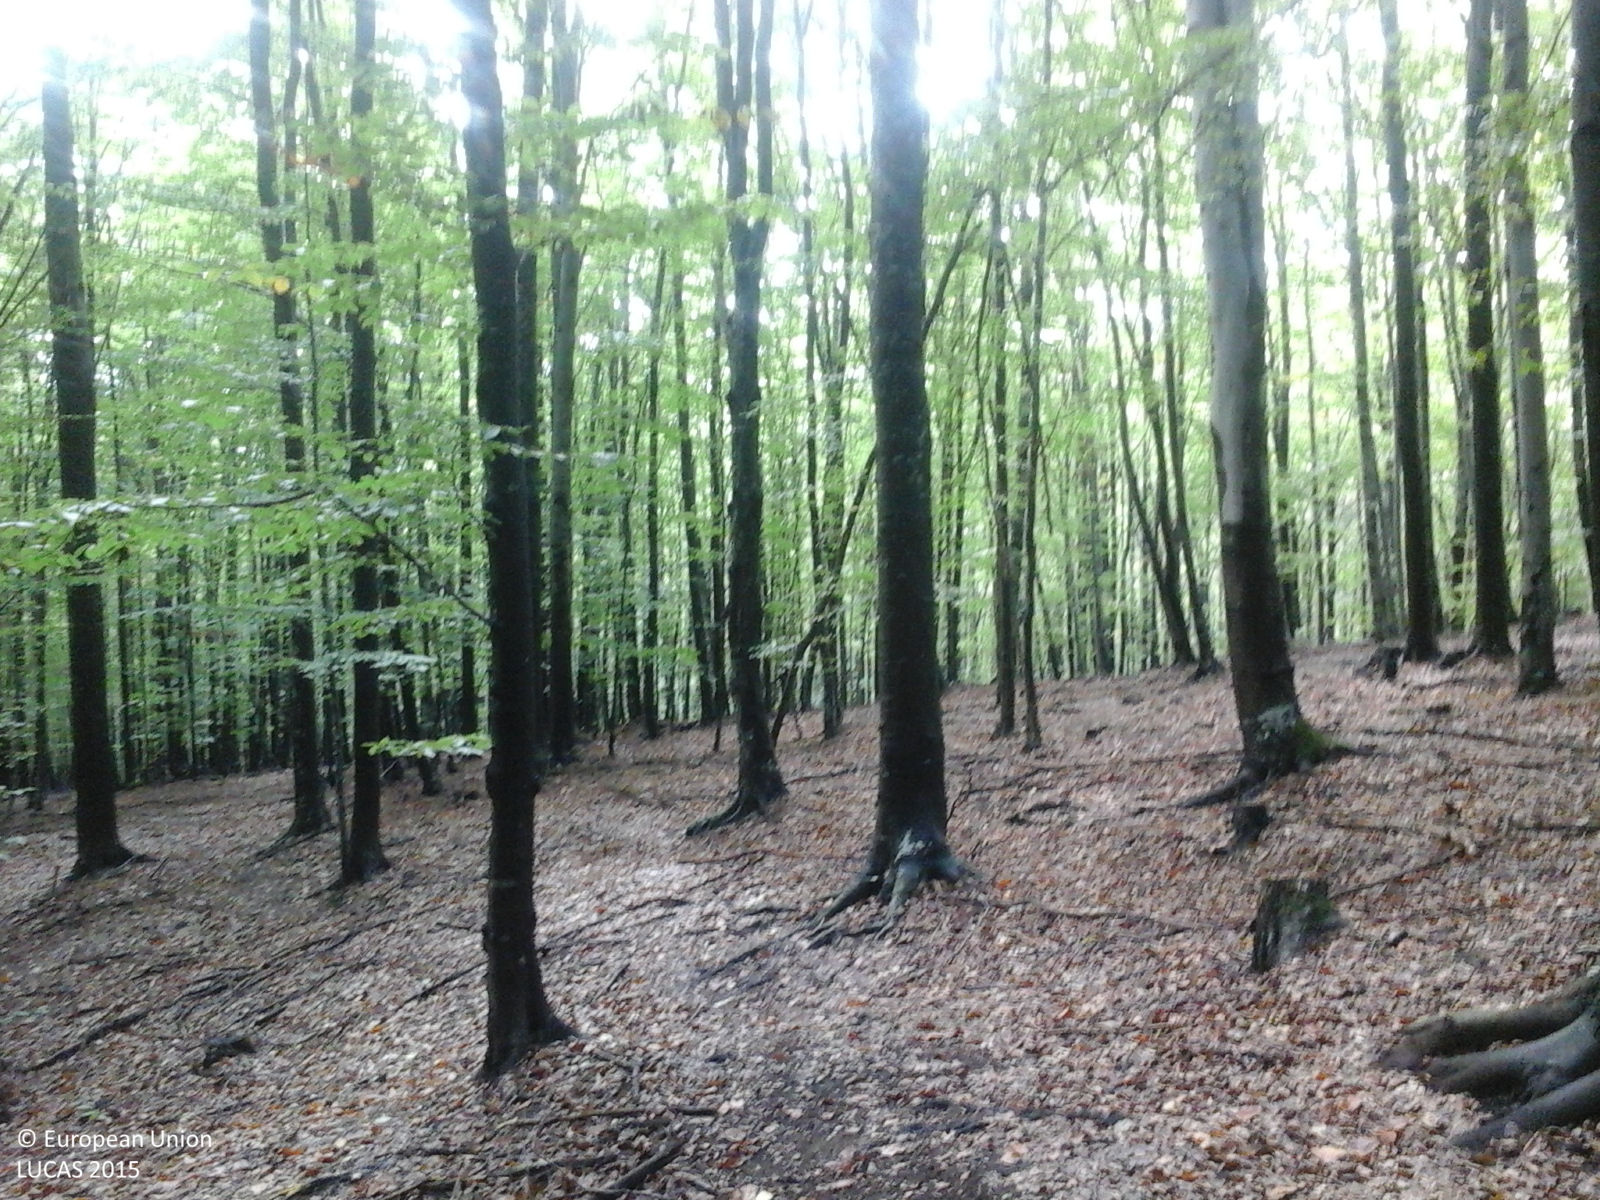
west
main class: Woodland
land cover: Broadleaved woodland
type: beech forest
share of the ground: > 75 %
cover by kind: broadleaved forest trees 100 %
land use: Forestry
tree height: > 5 m
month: September
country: RO
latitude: 45.3121
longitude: 24.4262
